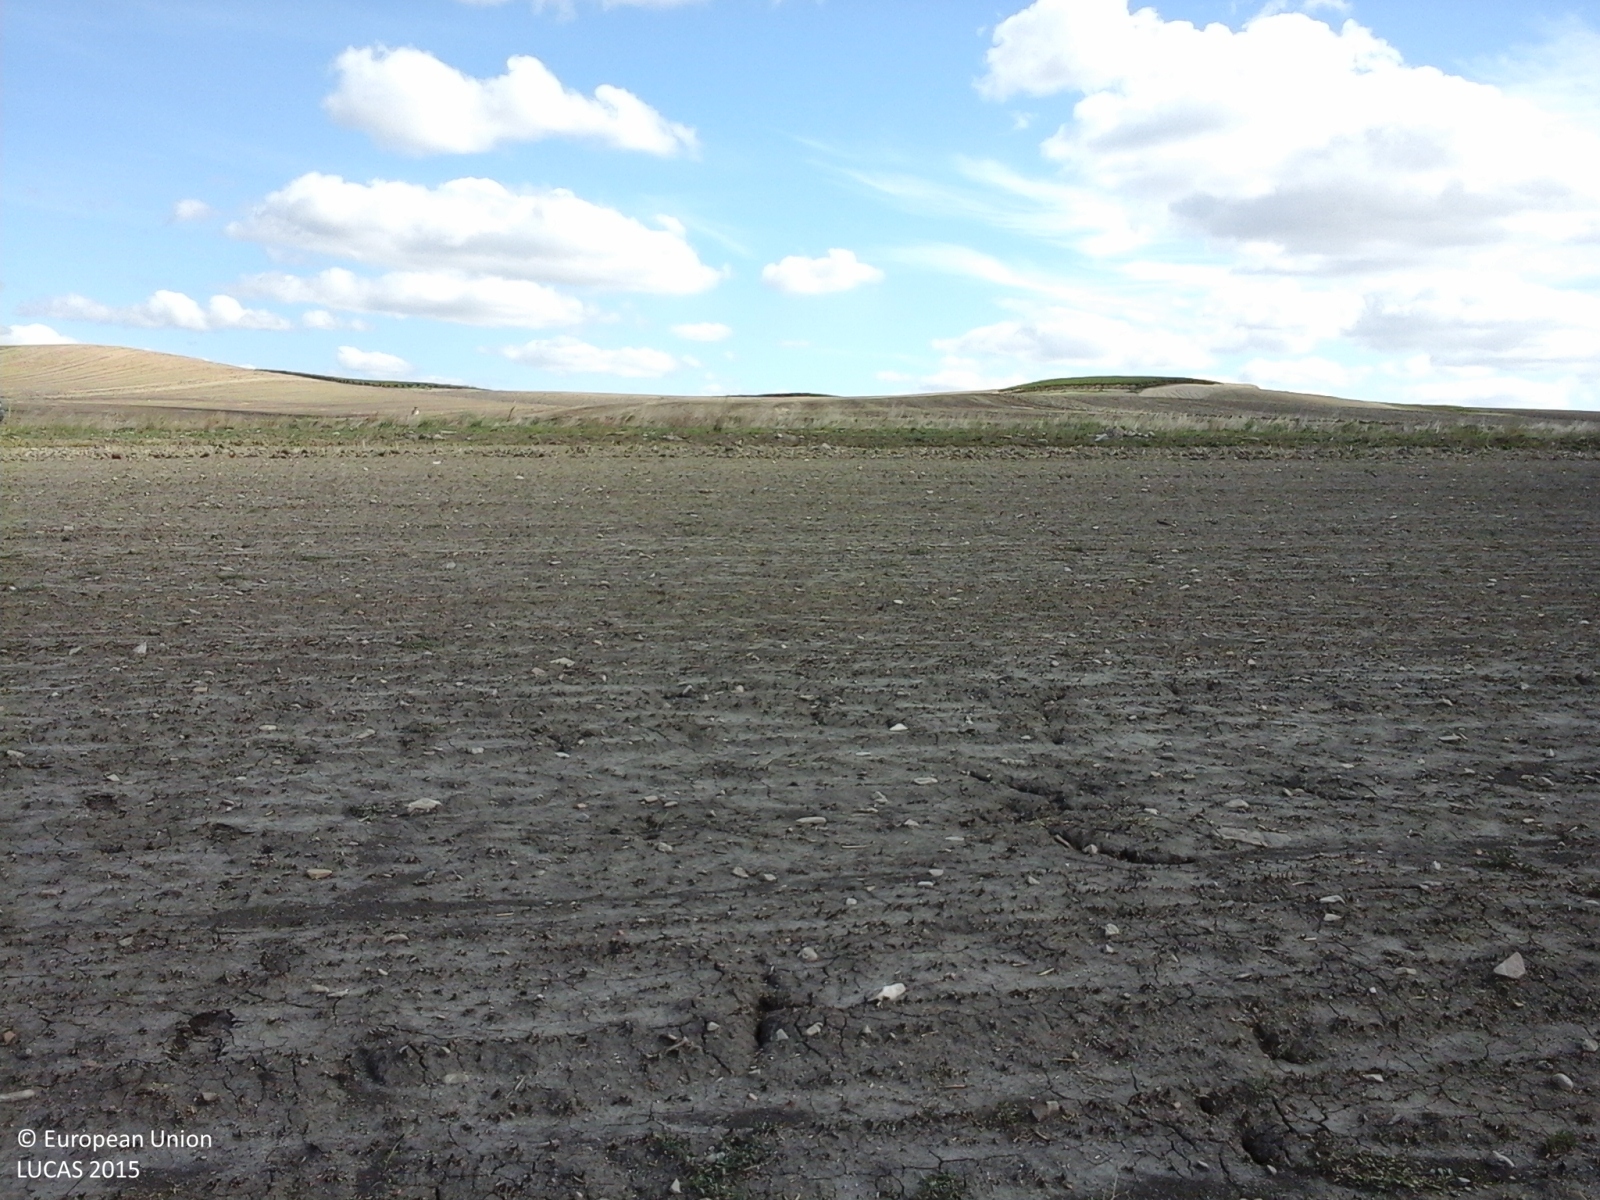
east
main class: Cropland
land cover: Durum wheat
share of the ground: > 75 %
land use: Agriculture (excluding fallow land and kitchen gardens)
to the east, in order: Durum wheat; Grassland without tree/shrub cover; Tracks; Grass margins; Durum wheat
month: September
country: IT
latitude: 41.6332
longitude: 15.2049
